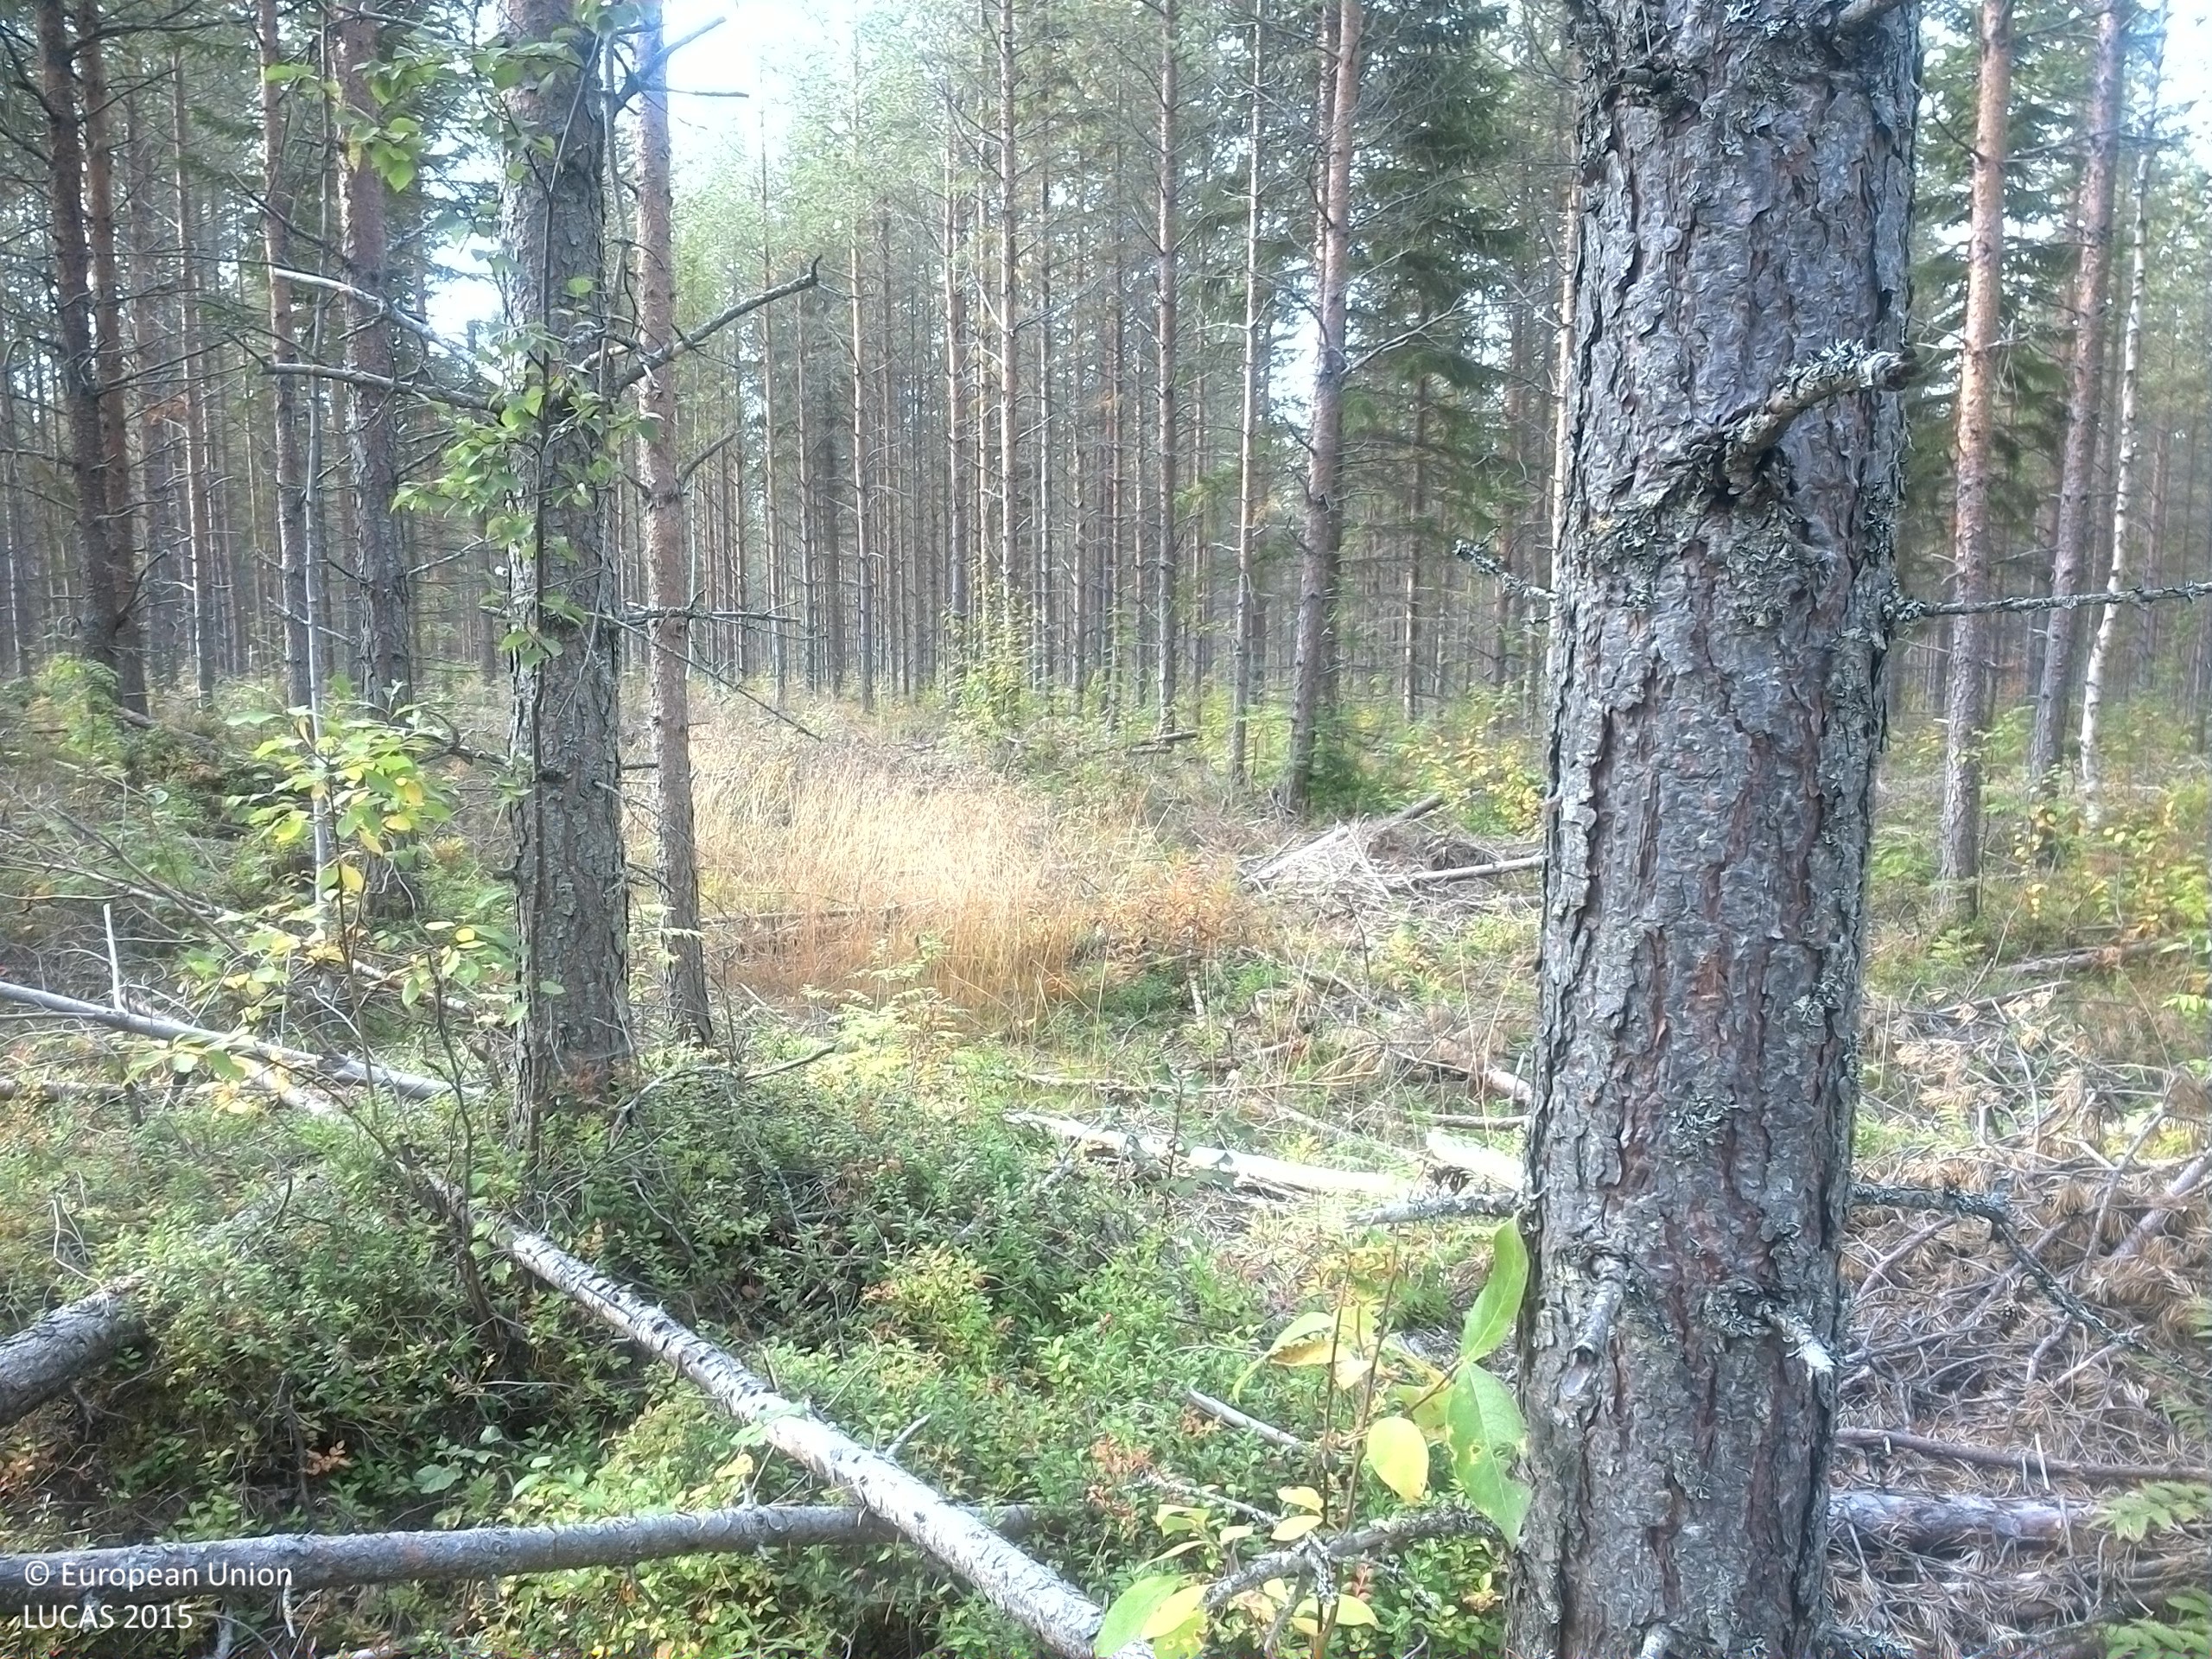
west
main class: Woodland
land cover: Pine dominated coniferous woodland
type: boreal forest
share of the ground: 50 - 75 %
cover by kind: coniferous forest trees 45 %, shrubs 35 %, lichens and mosses 10 %, broadleaved forest trees 5 %, herbaceous plants 5 %
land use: Forestry
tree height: > 5 m
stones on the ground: < 10 %
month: September
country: SE
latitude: 63.8336
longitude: 16.4150
